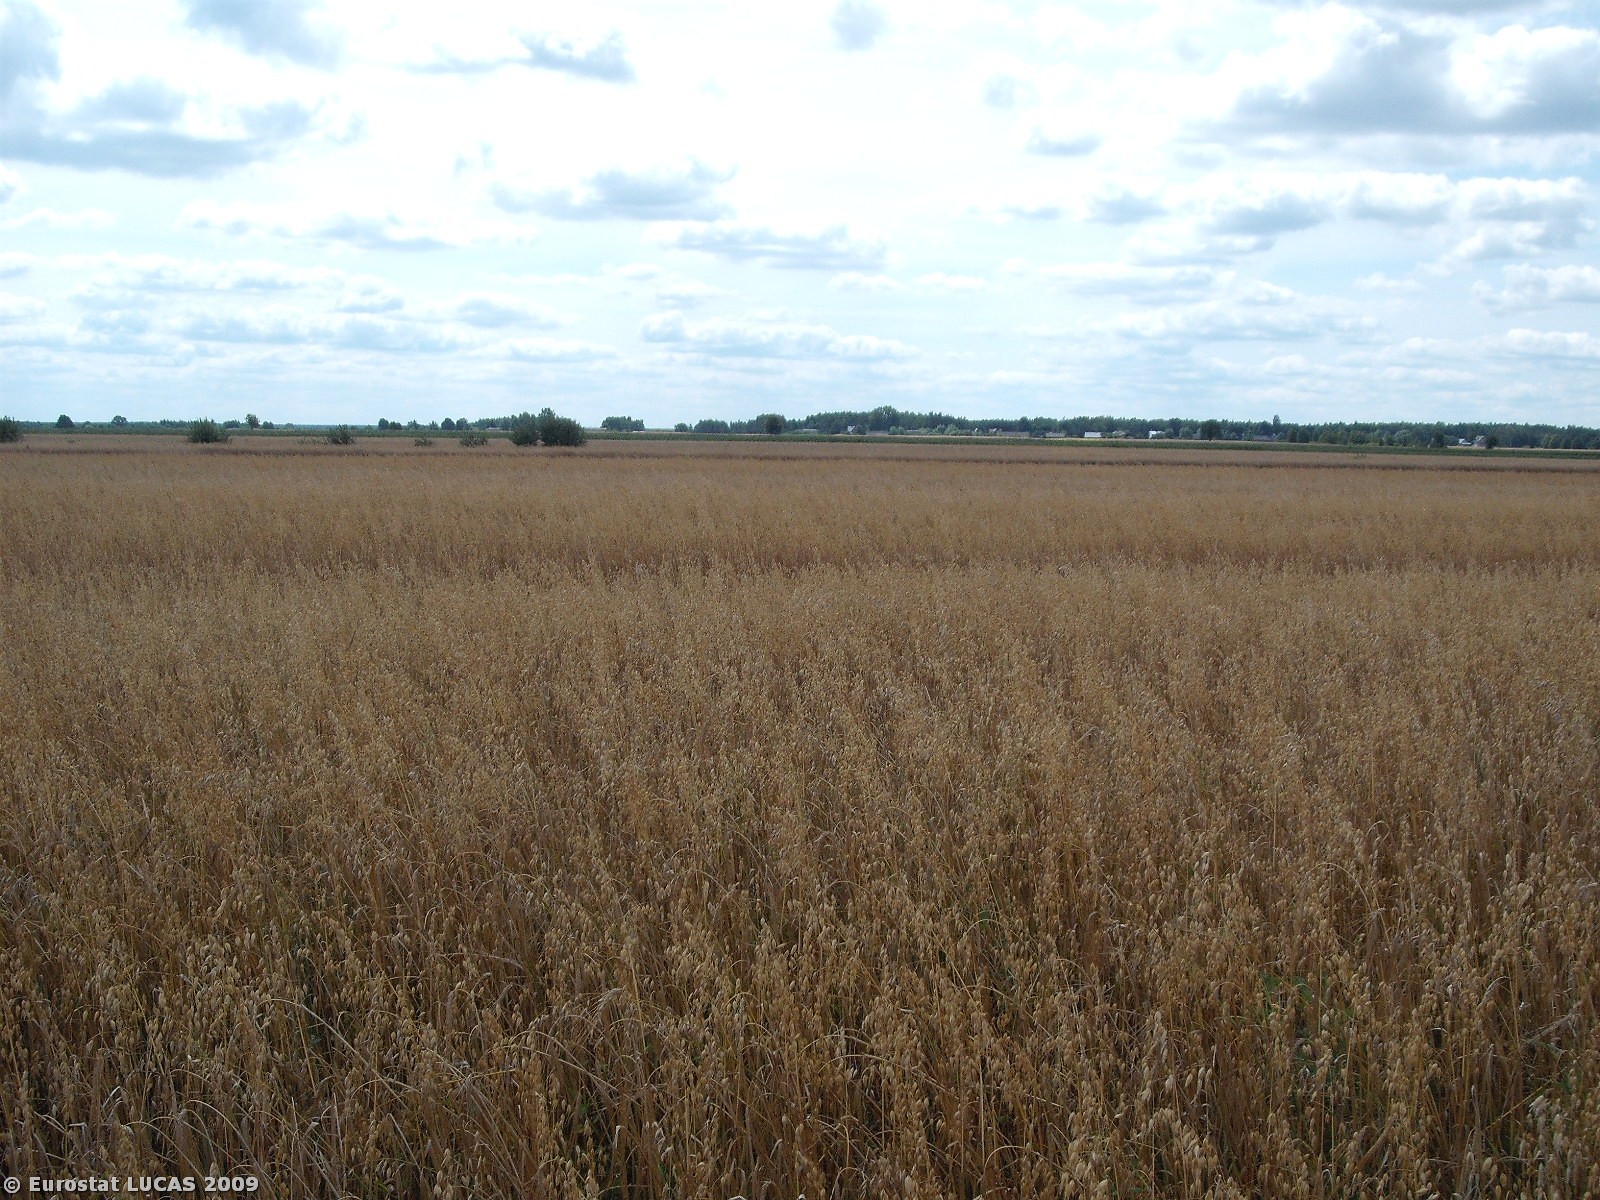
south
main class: Cropland
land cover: Barley
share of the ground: 50 - 75 %
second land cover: Oats
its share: 25 - 50 %
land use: Agriculture (excluding fallow land and kitchen gardens)
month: July
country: PL
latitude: 51.3178
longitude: 21.3992
